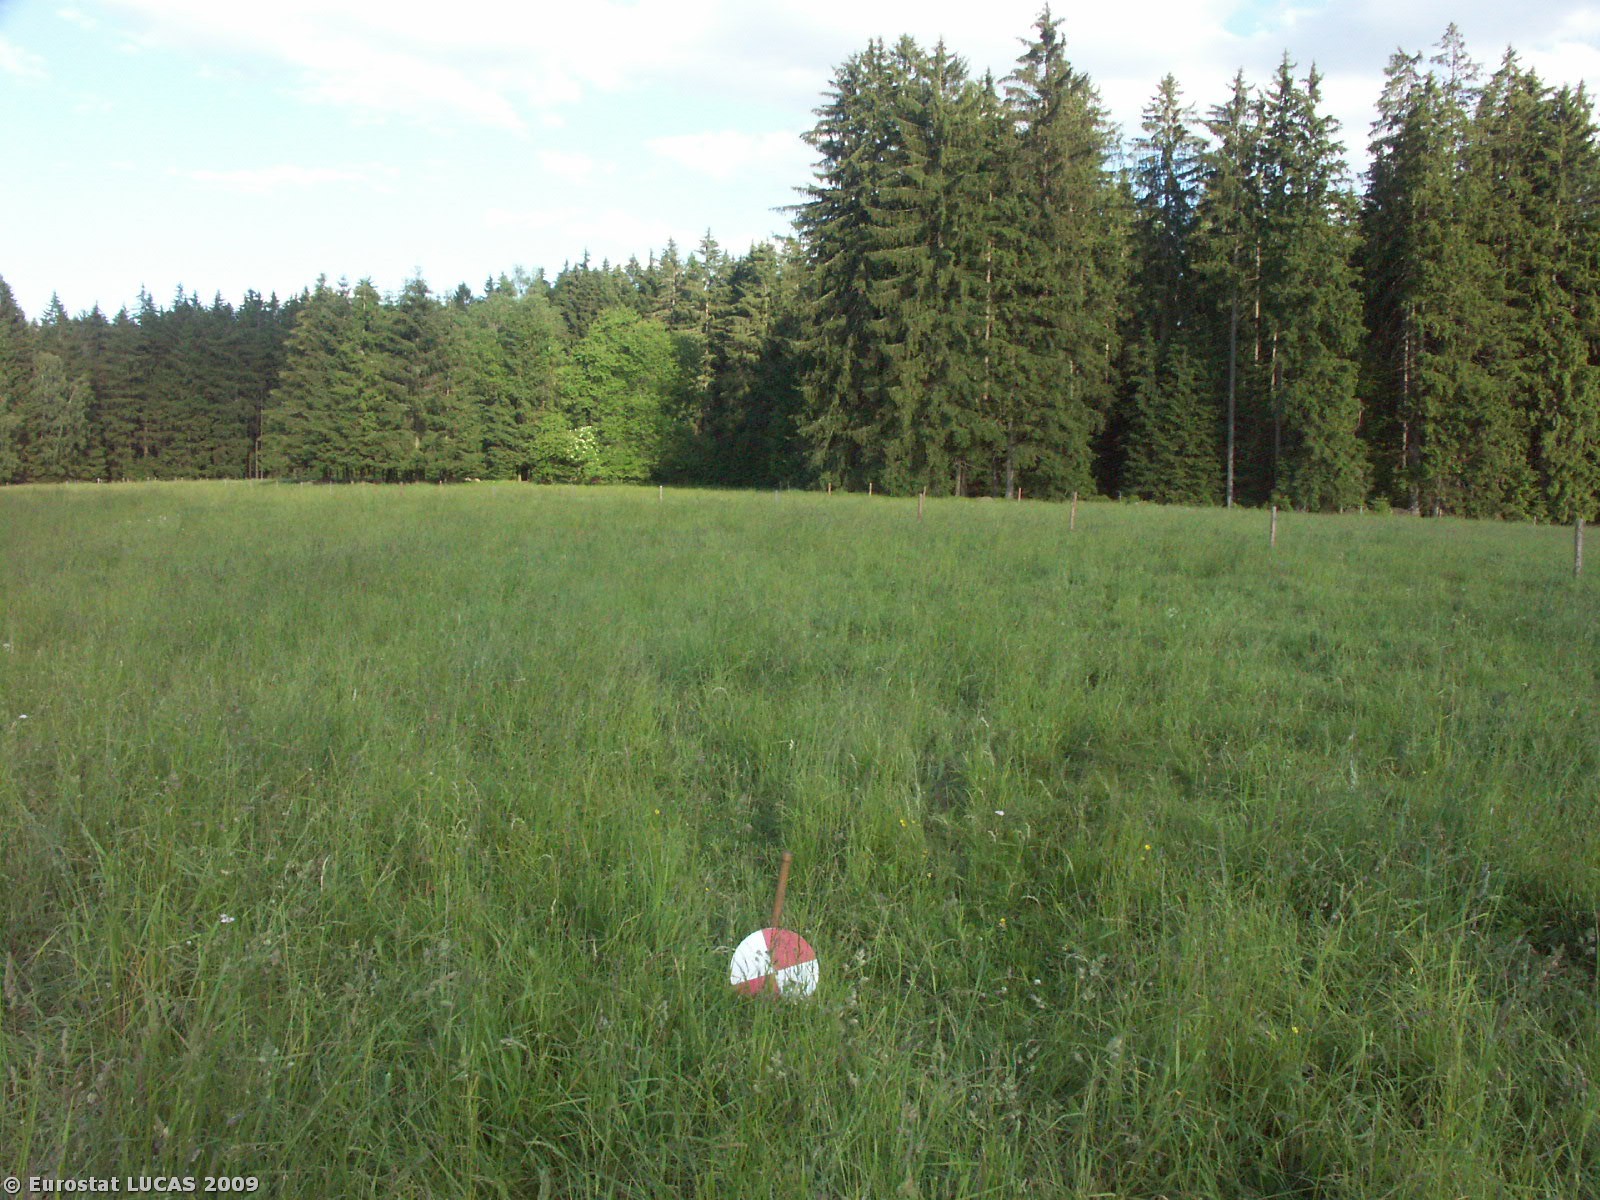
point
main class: Grassland
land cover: Grassland without tree/shrub cover
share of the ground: > 75 %
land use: Agriculture (excluding fallow land and kitchen gardens)
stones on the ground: < 10 %
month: June
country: CZ
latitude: 48.7031
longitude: 14.1720
